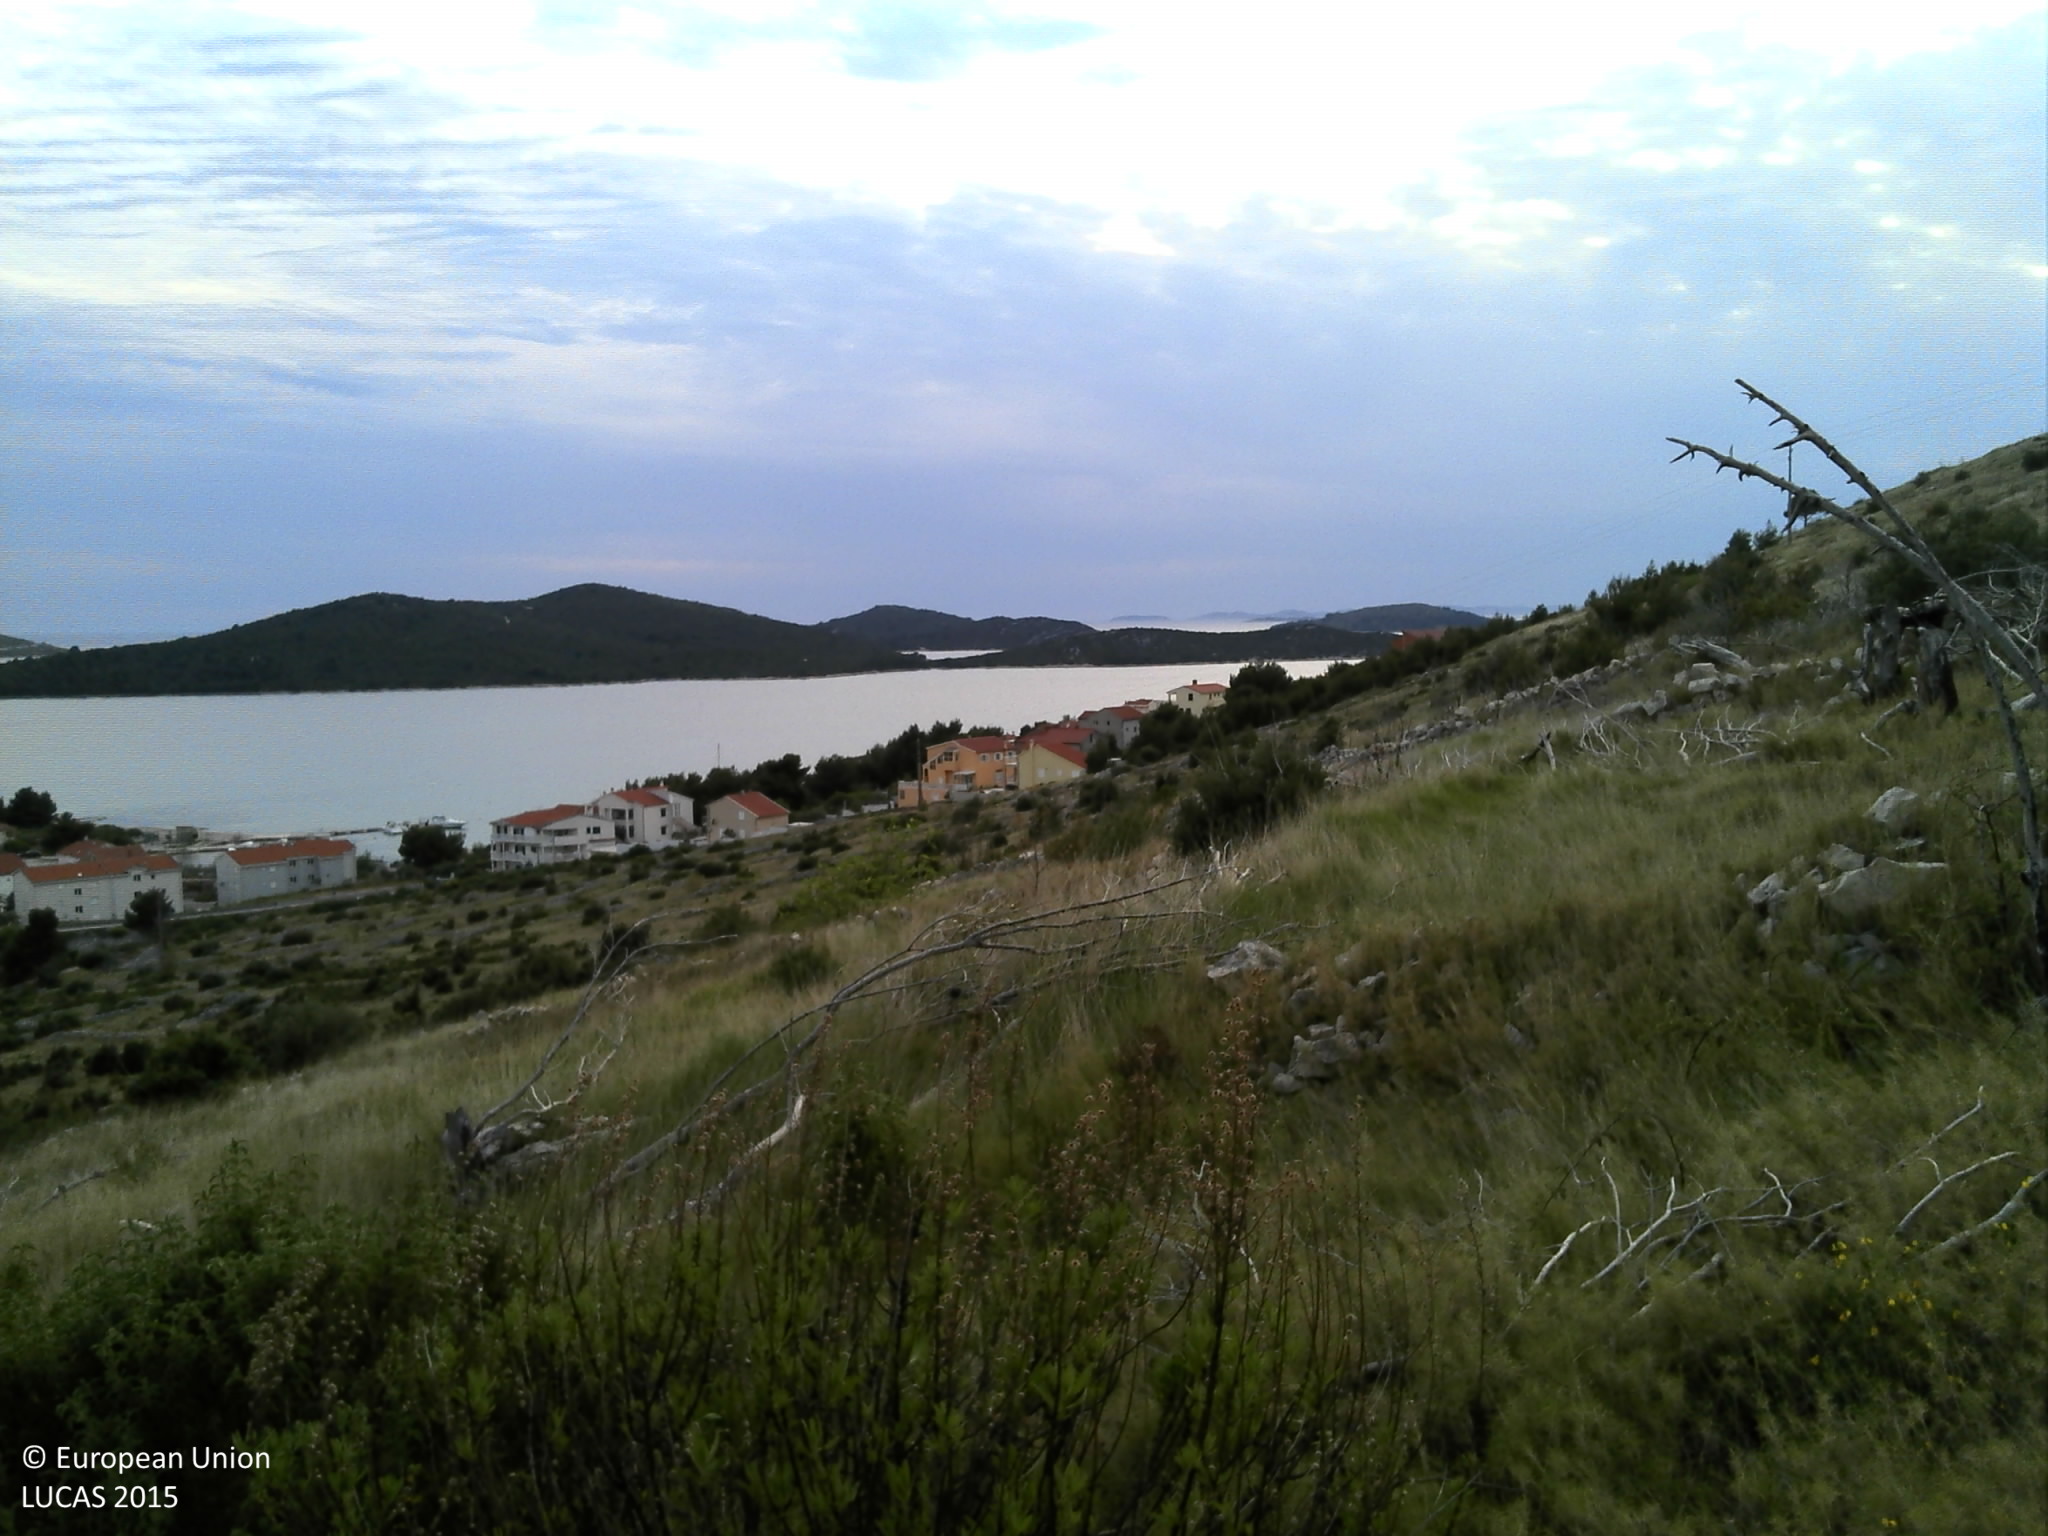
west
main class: Grassland
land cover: Grassland with sparse tree/shrub cover
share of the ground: > 75 %
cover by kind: herbaceous plants 65 %, shrubs 10 %, consolidated bare surface 10 %, unconsolidated bare surface 10 %, coniferous forest trees 5 %
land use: Abandoned areas
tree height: < 5 m
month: April
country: HR
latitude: 43.6551
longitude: 15.9549
